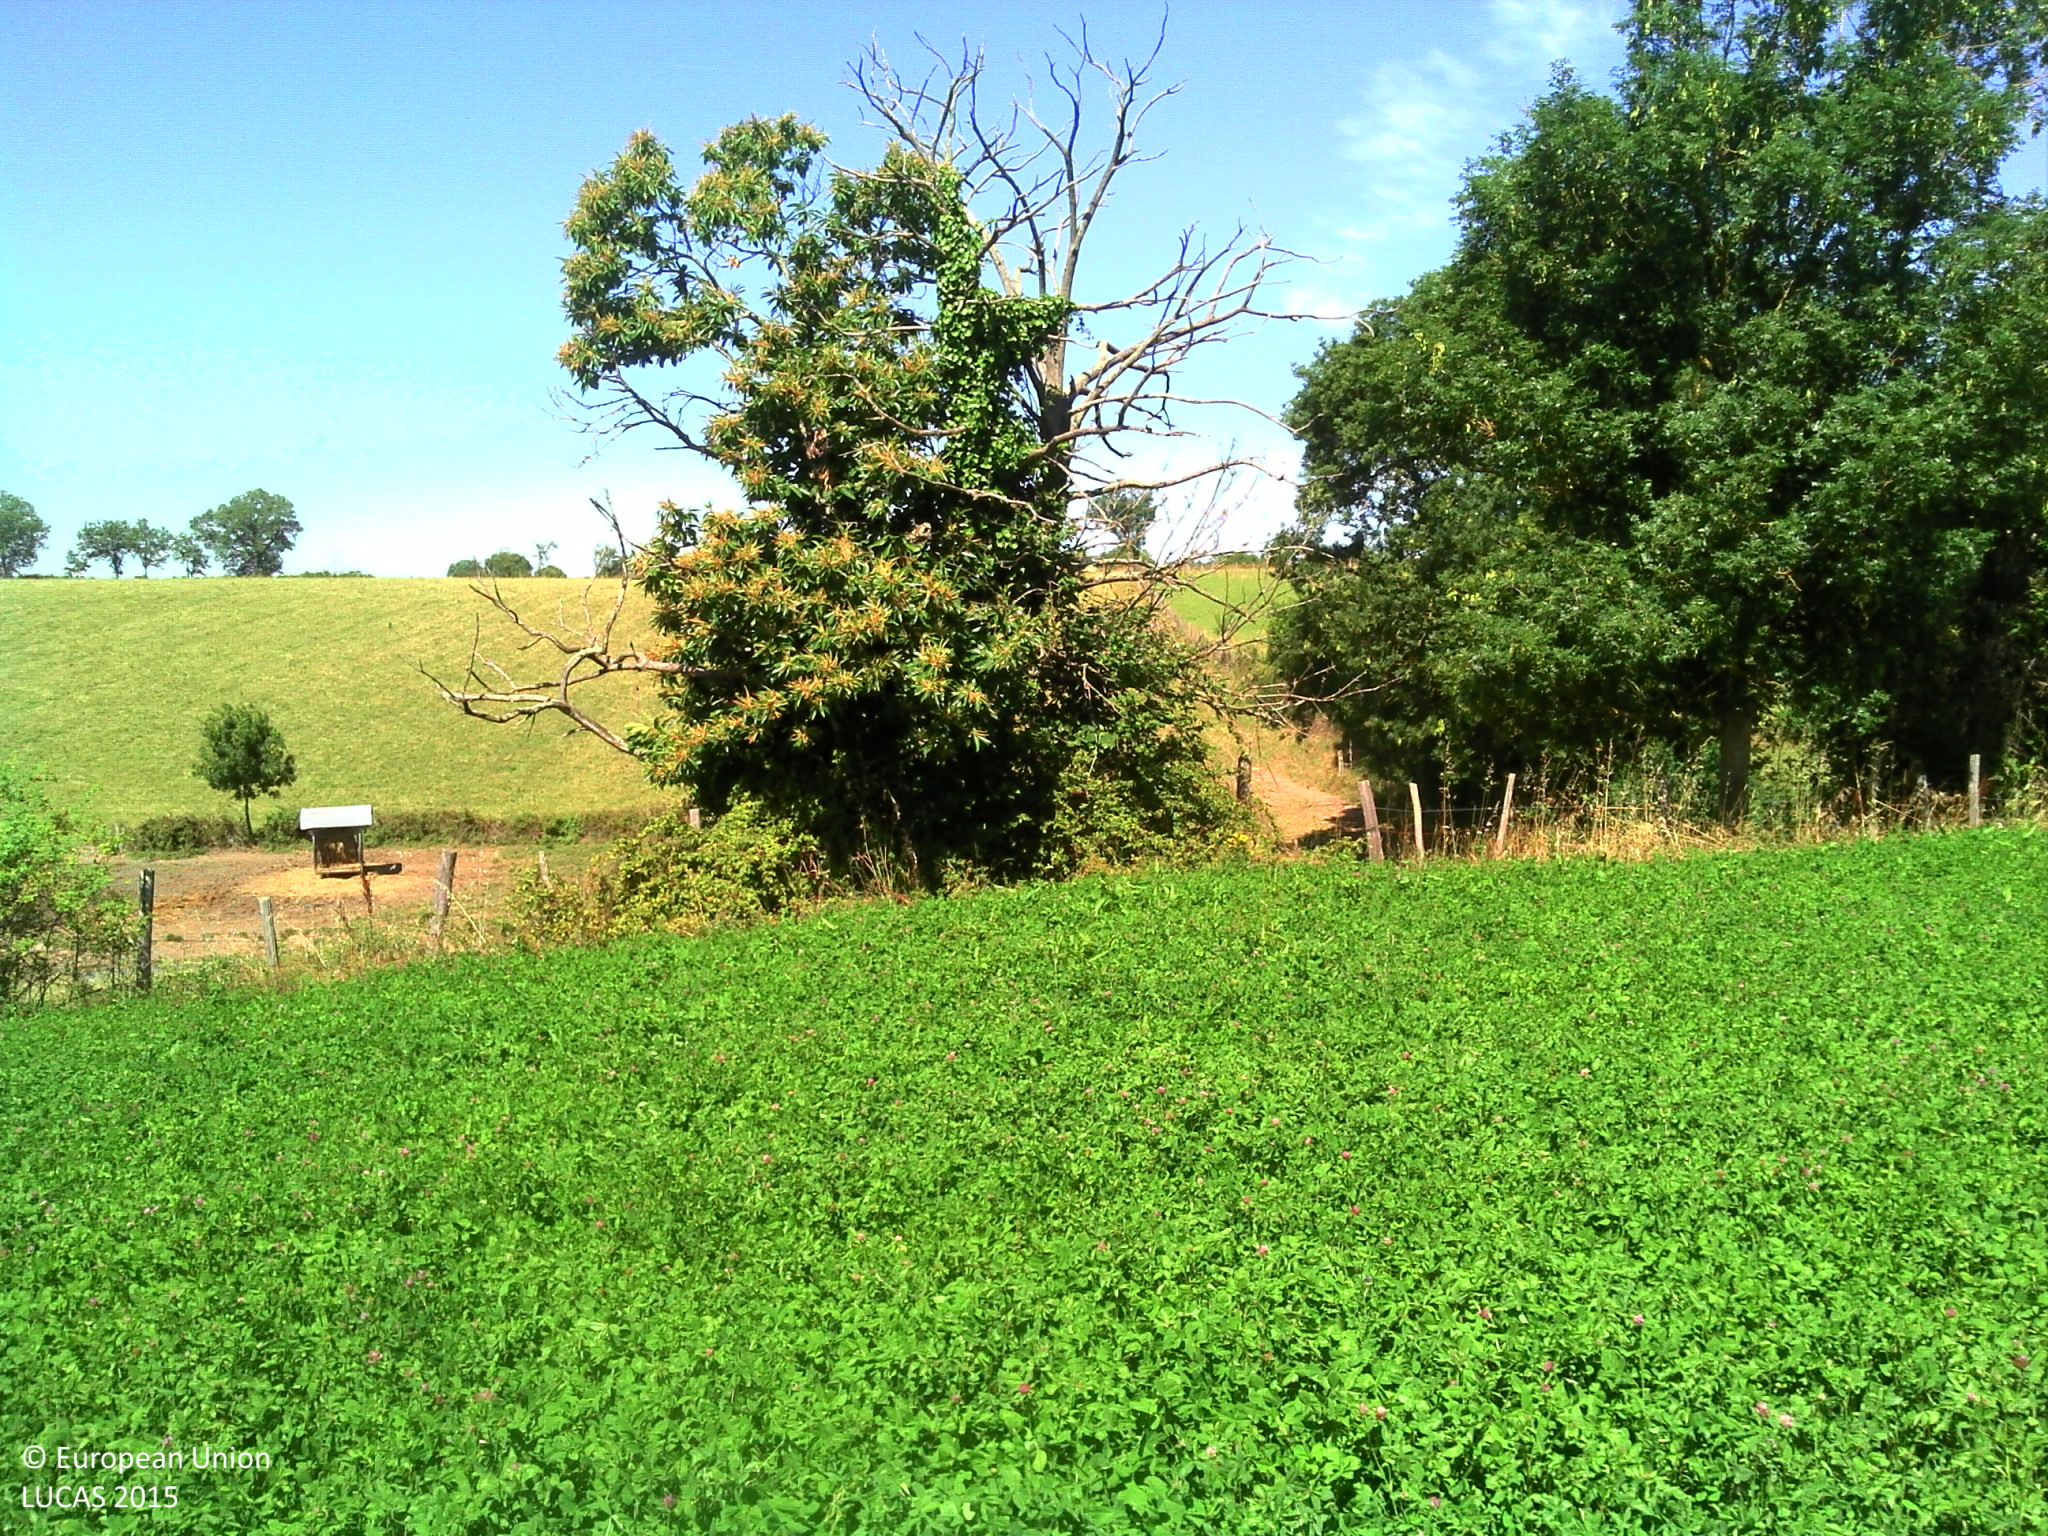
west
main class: Cropland
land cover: Clovers
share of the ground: > 75 %
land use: Agriculture (excluding fallow land and kitchen gardens)
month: June
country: FR
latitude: 44.0832
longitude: 2.0727
